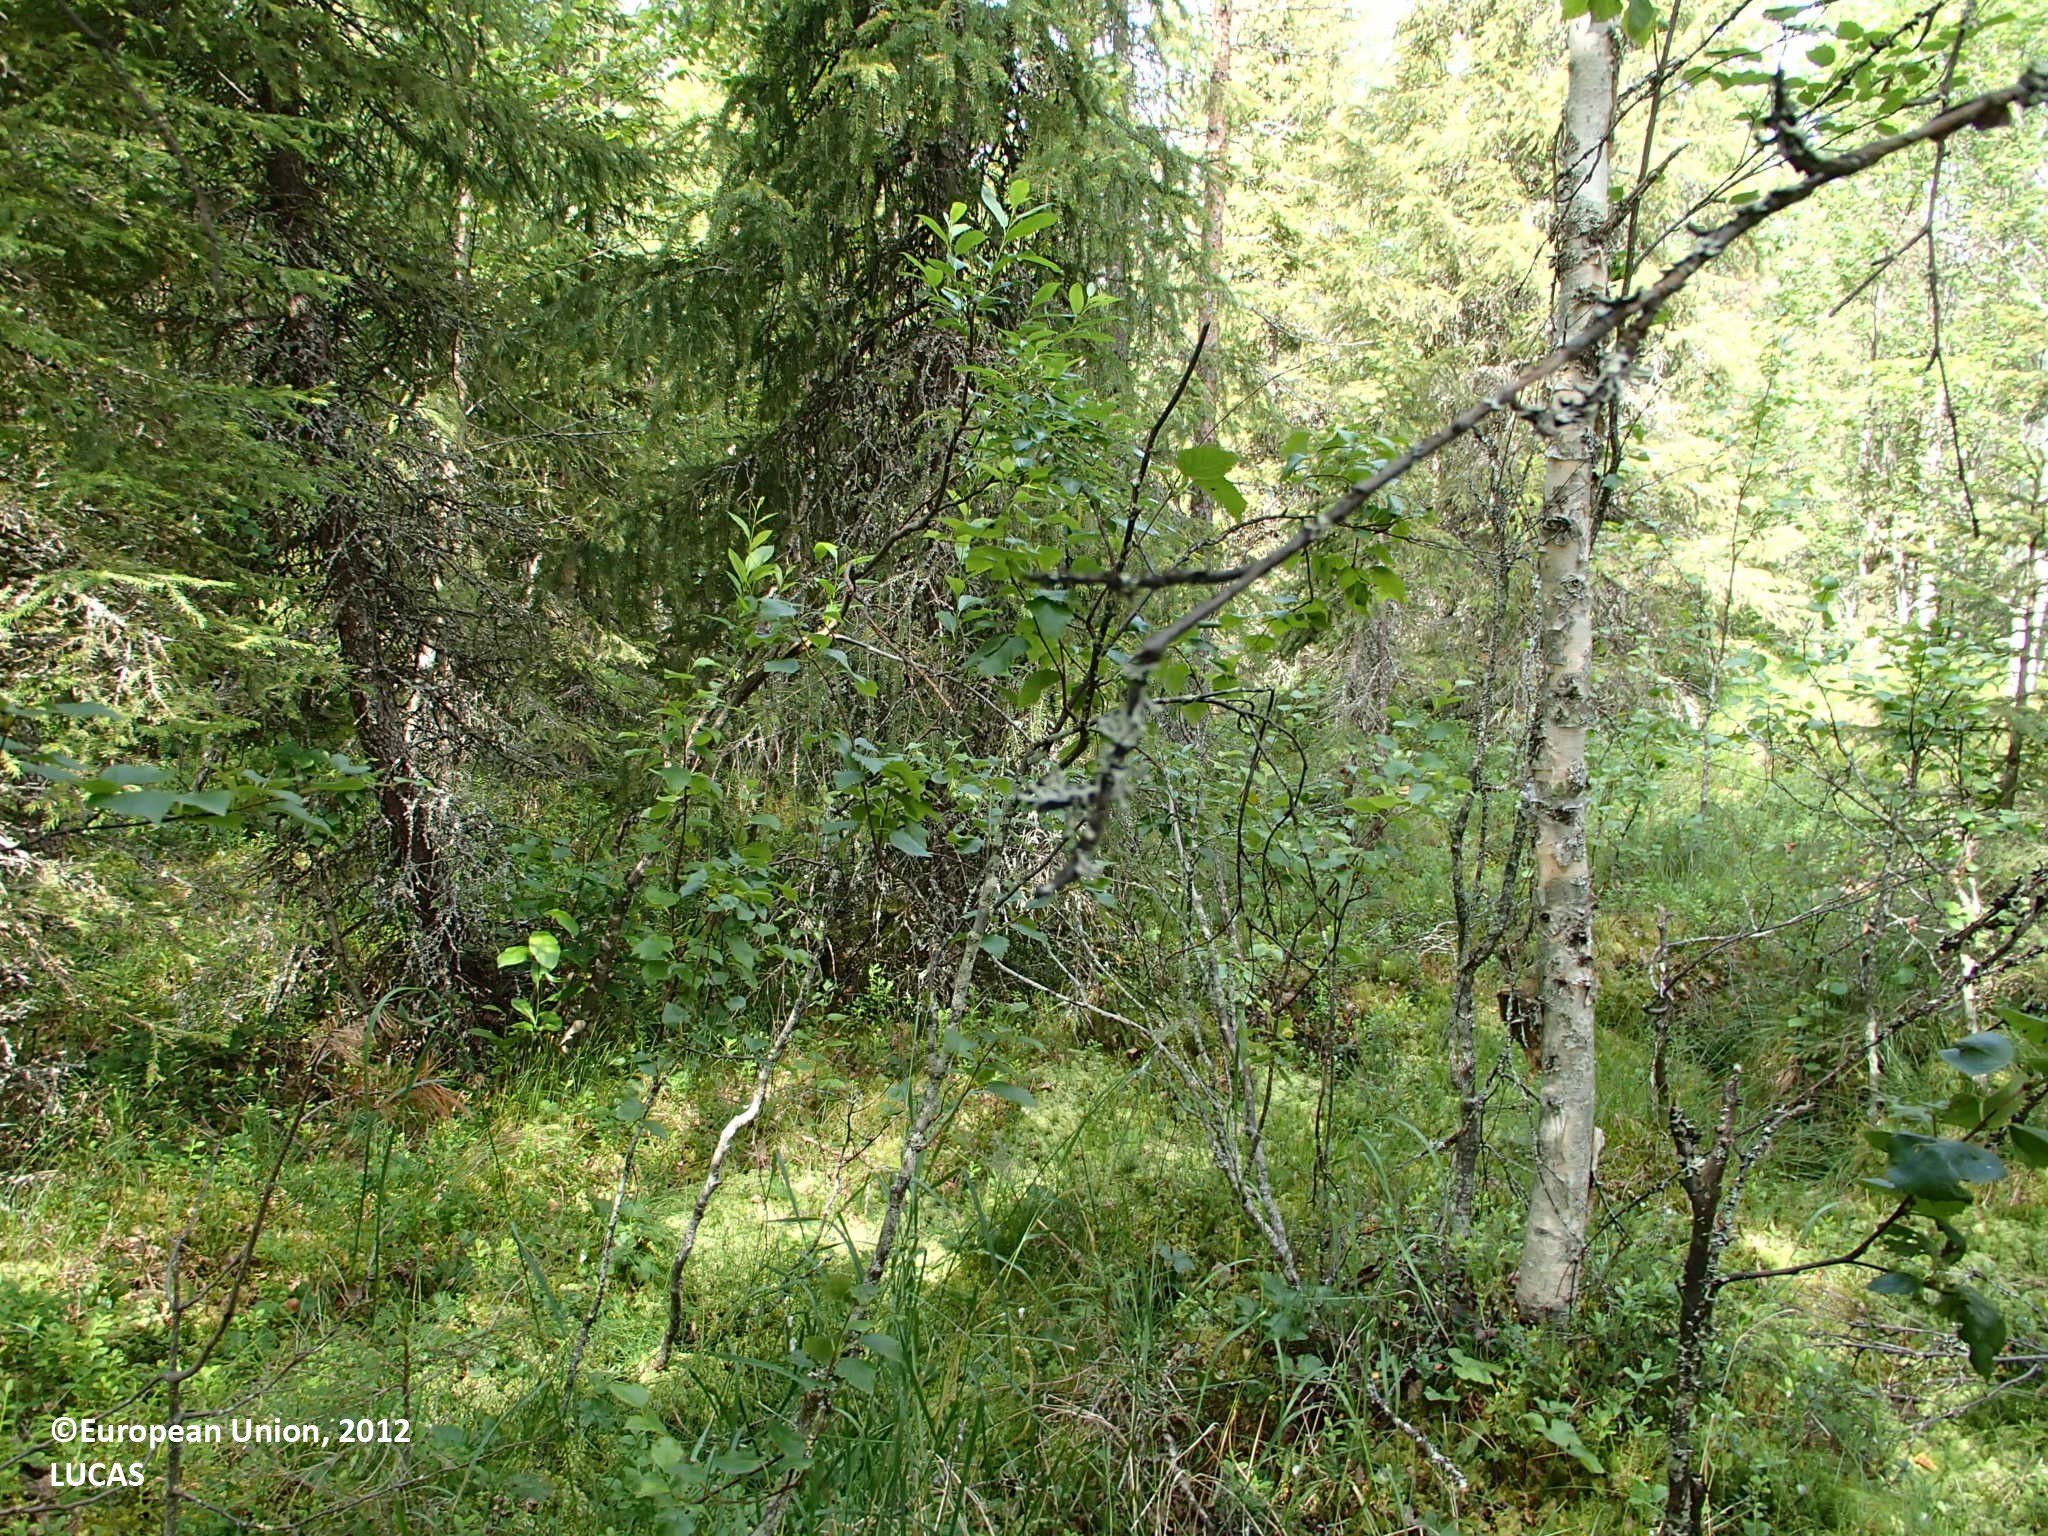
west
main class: Woodland
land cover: Other mixed woodland
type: boreal forest
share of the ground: > 75 %
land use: Forestry
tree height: > 5 m
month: July
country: FI
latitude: 66.3545
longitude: 25.4599
